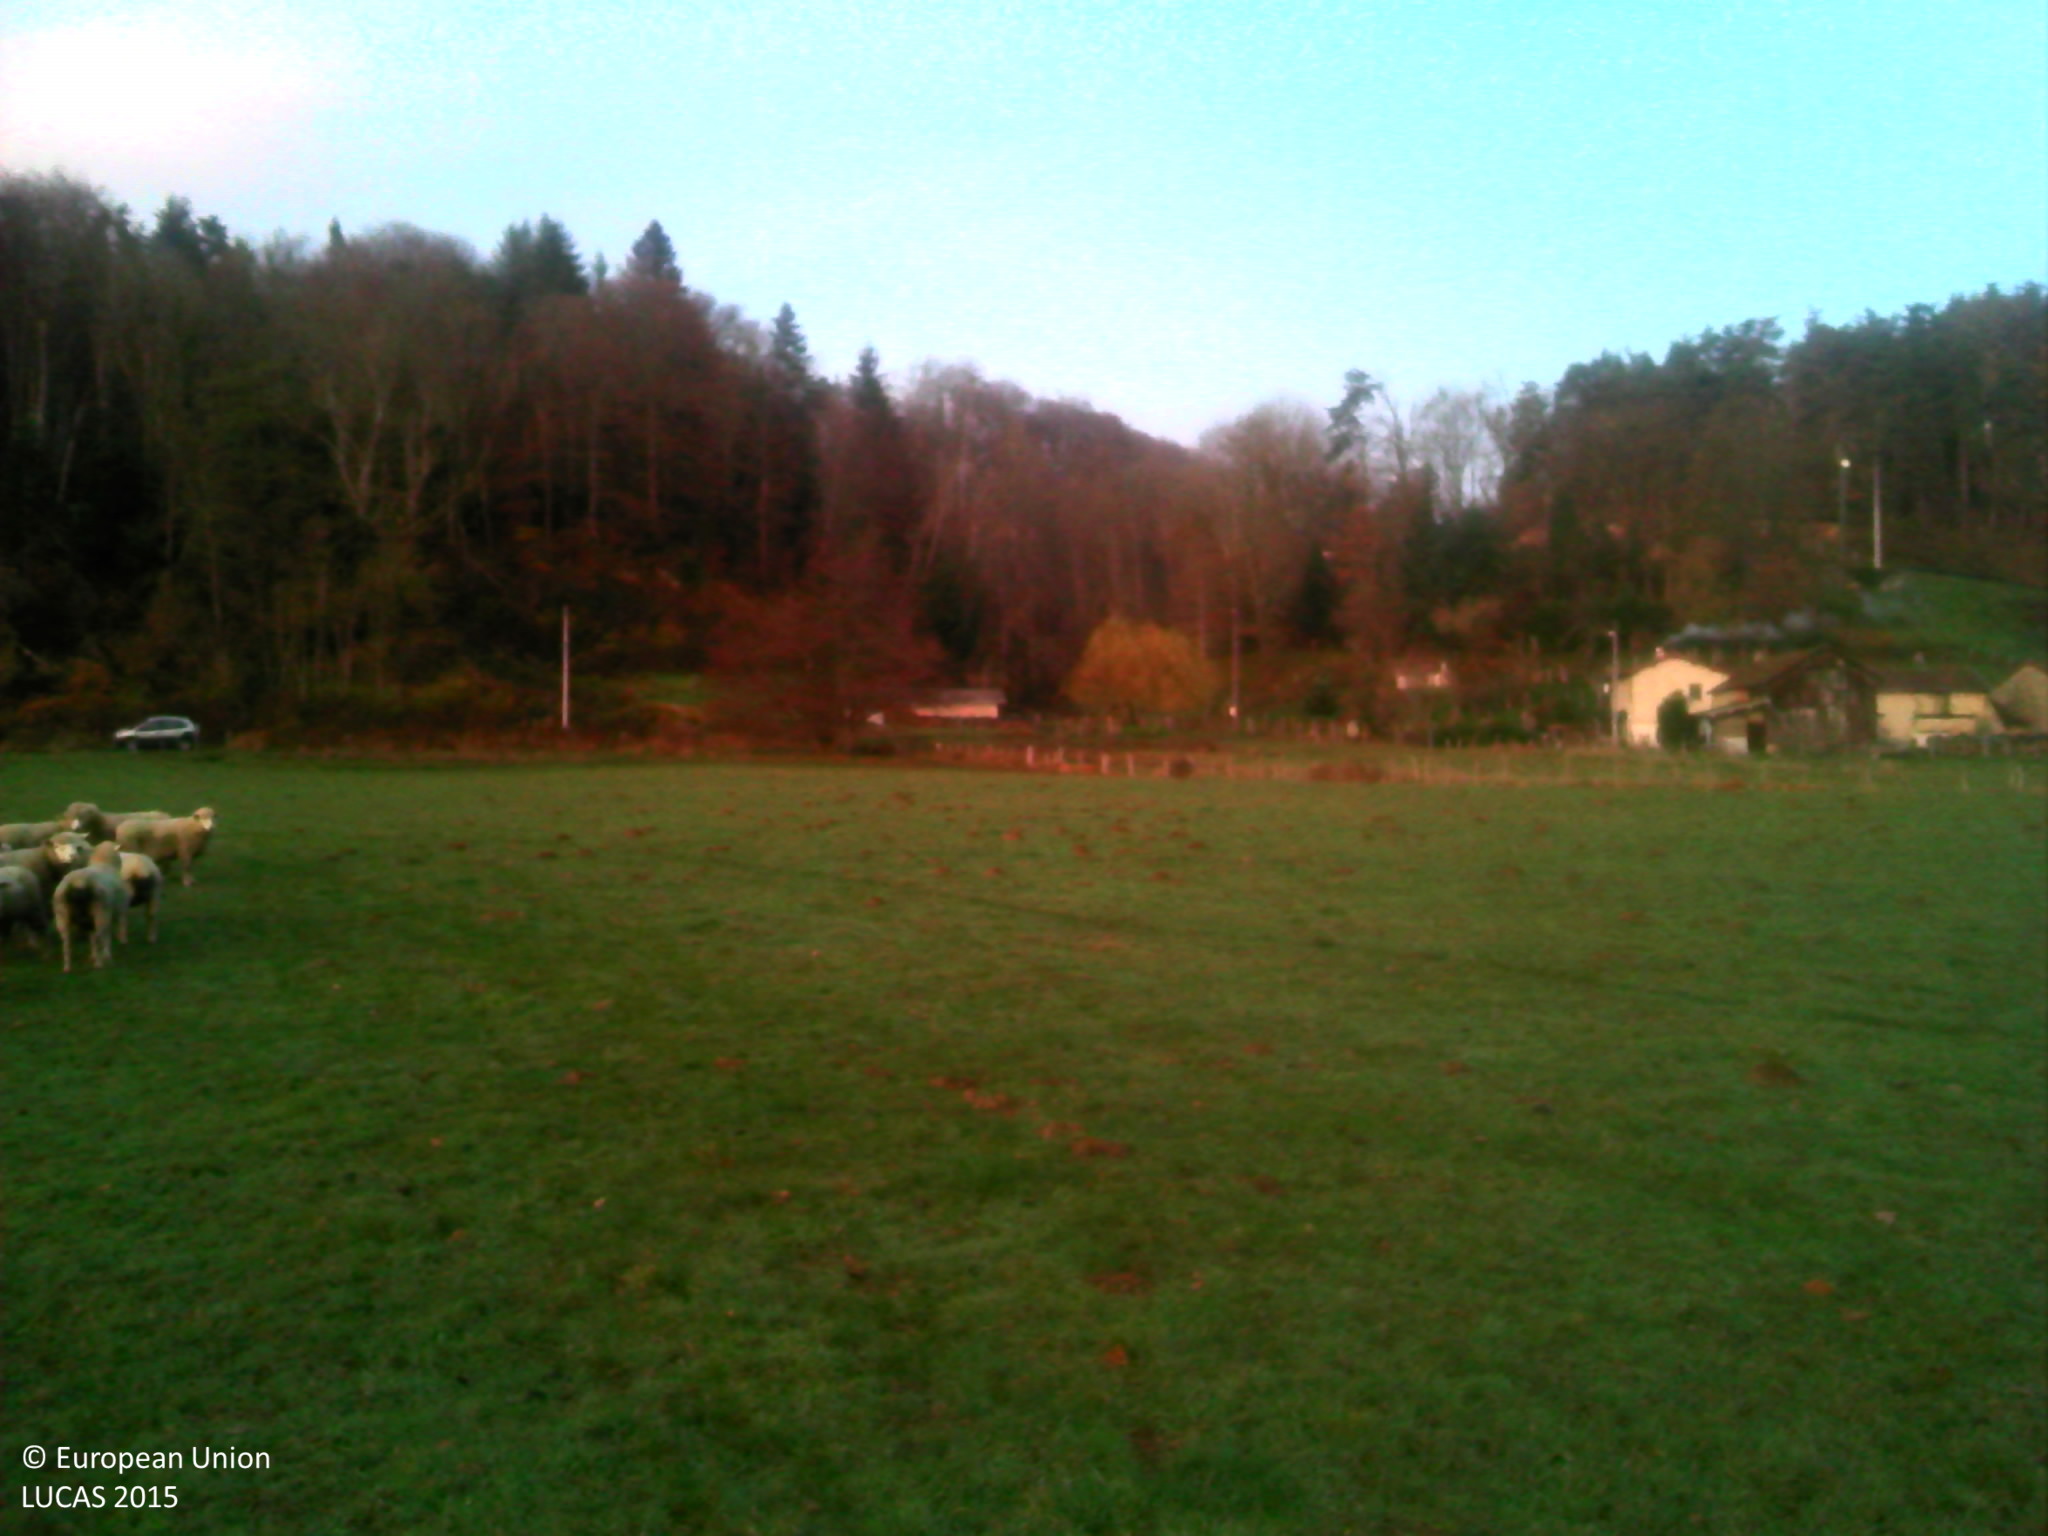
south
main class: Grassland
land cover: Grassland without tree/shrub cover
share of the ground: > 75 %
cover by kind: herbaceous plants 100 %
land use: Agriculture (excluding fallow land and kitchen gardens)
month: November
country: FR
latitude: 46.0574
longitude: 3.7058
